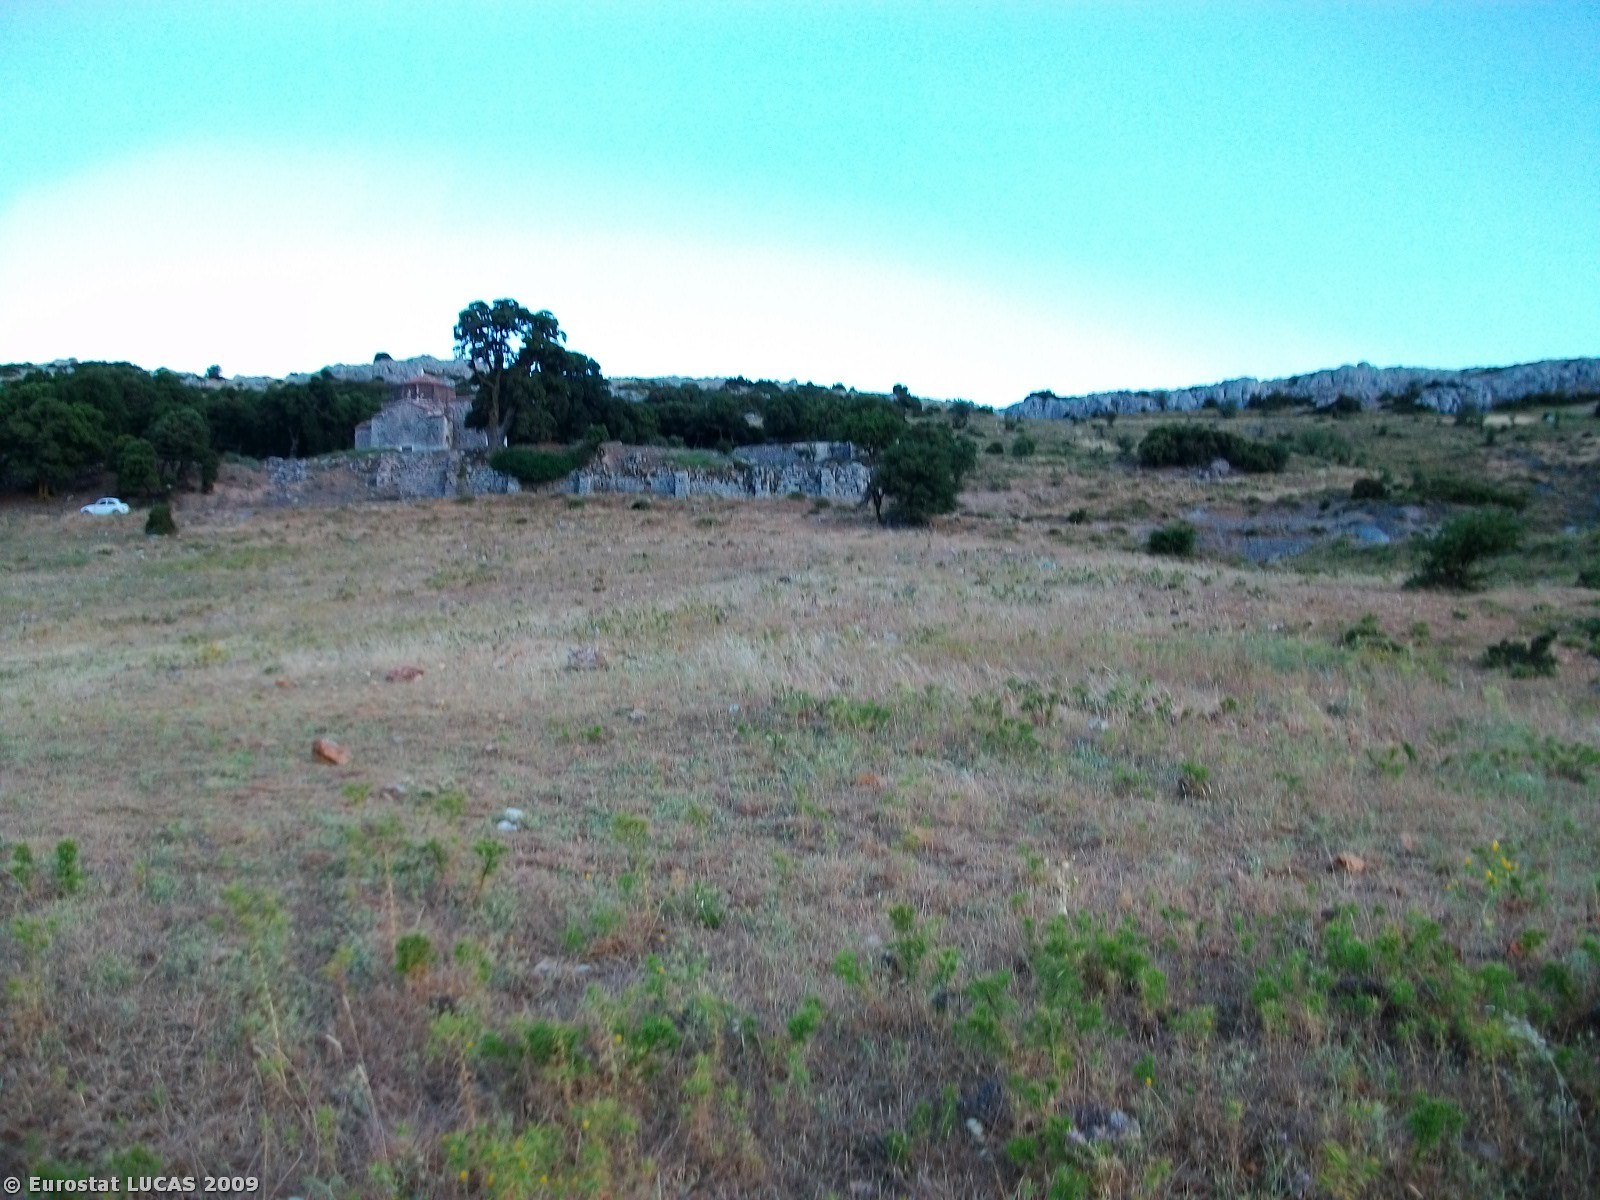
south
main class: Grassland
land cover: Grassland with sparse tree/shrub cover
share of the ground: > 75 %
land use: Agriculture (excluding fallow land and kitchen gardens)
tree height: < 5 m
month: June
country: GR
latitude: 38.2157
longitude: 23.4700
